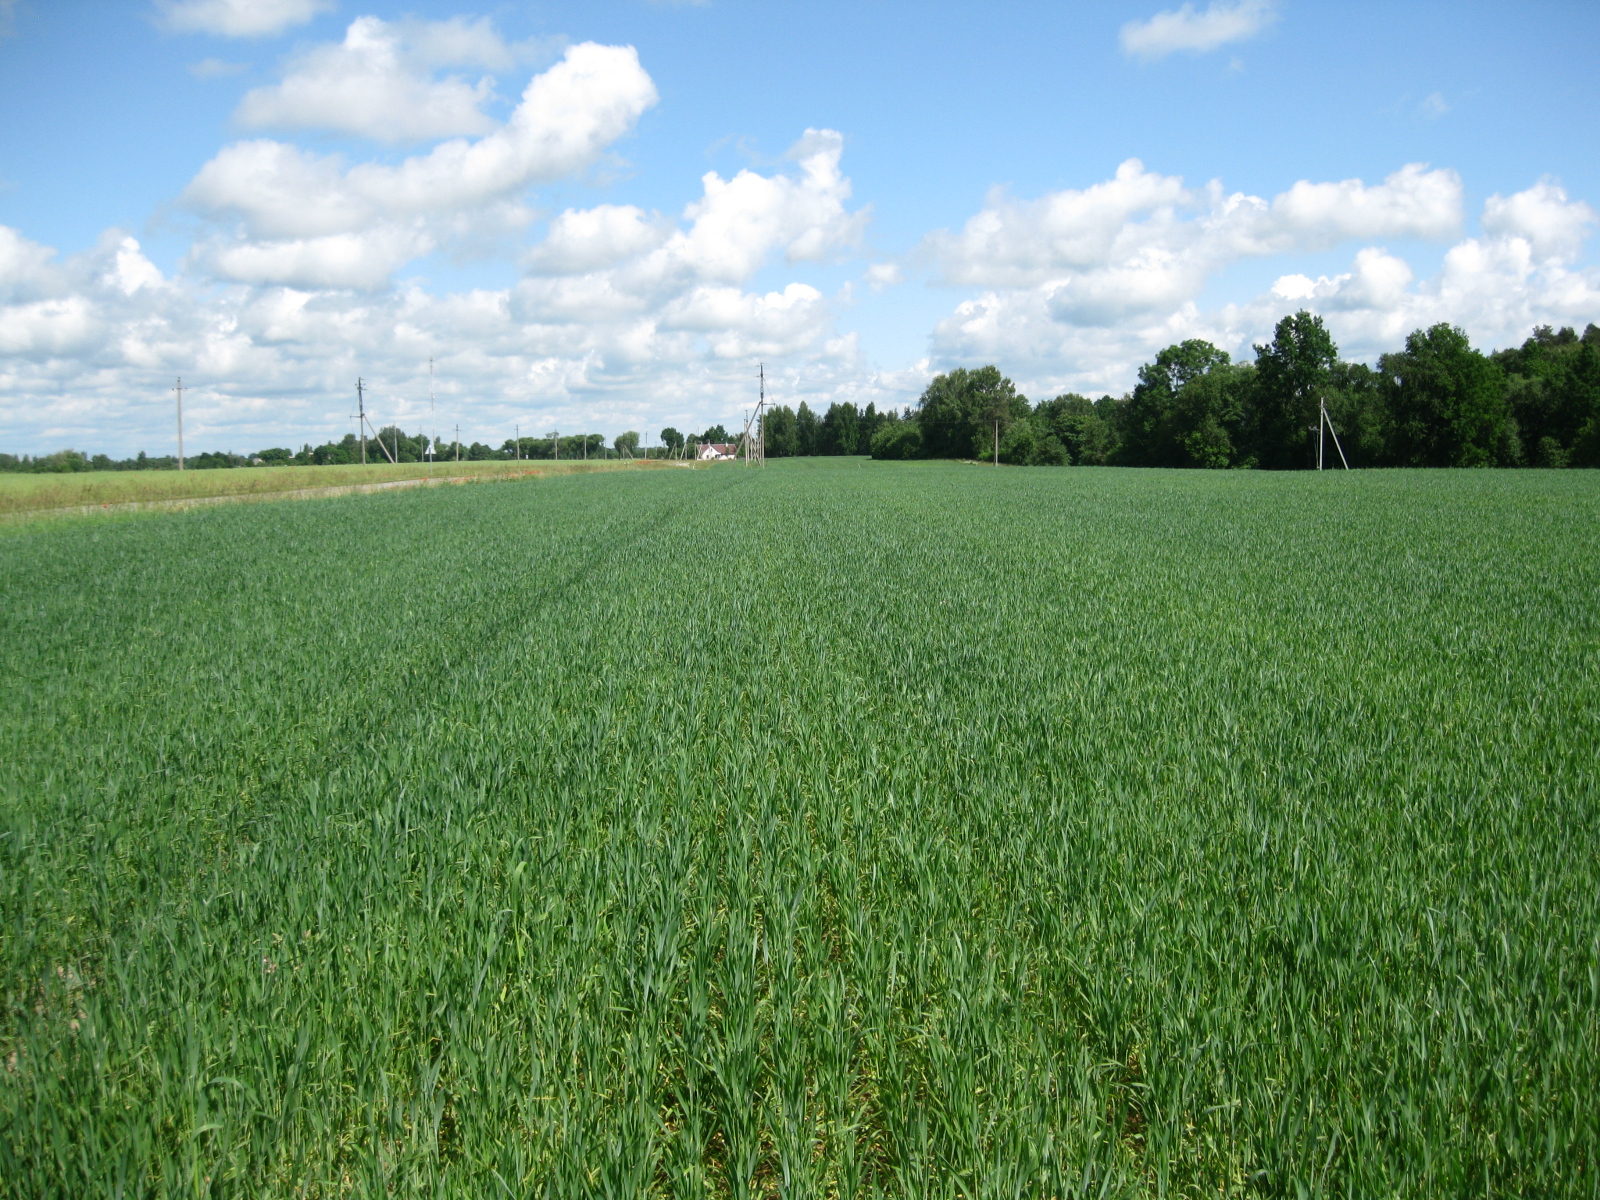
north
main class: Cropland
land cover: Triticale
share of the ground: > 75 %
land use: Agriculture (excluding fallow land and kitchen gardens)
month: June
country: LT
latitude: 55.5303
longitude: 24.1124
